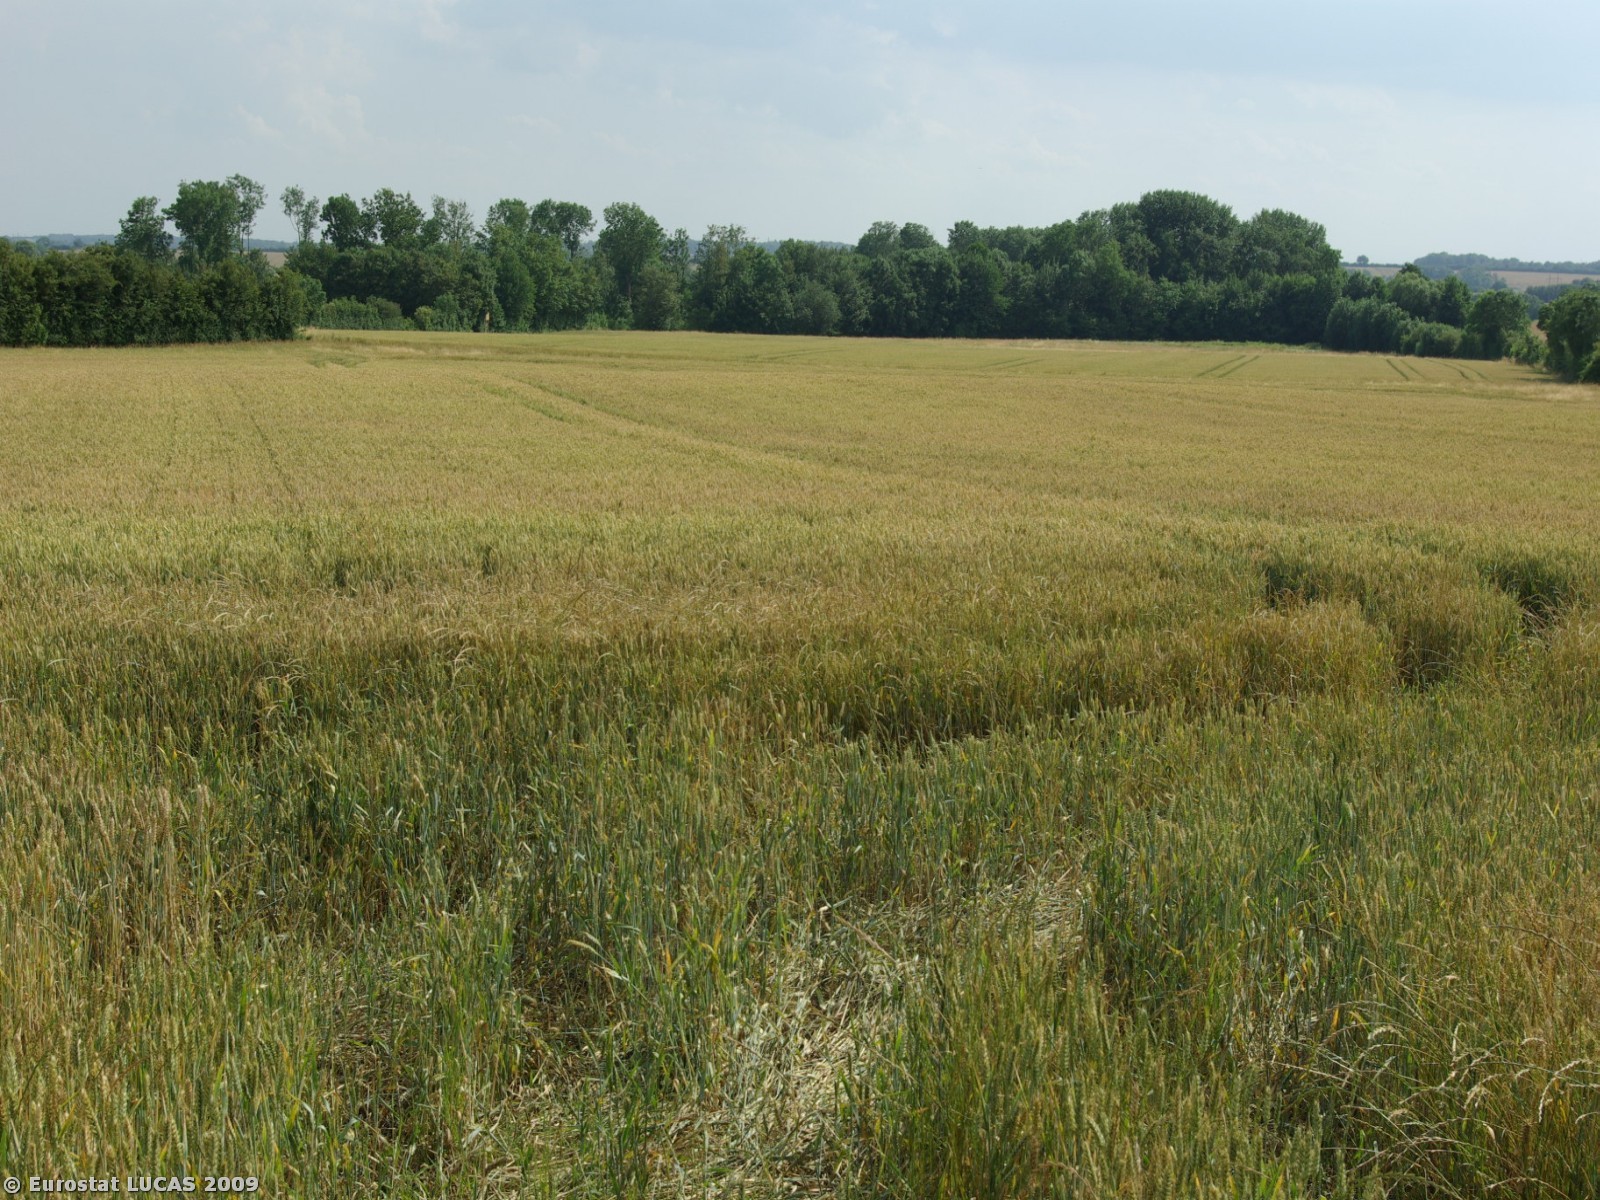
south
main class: Cropland
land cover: Common wheat
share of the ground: > 75 %
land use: Agriculture (excluding fallow land and kitchen gardens)
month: July
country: DK
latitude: 54.9834
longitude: 9.8595
